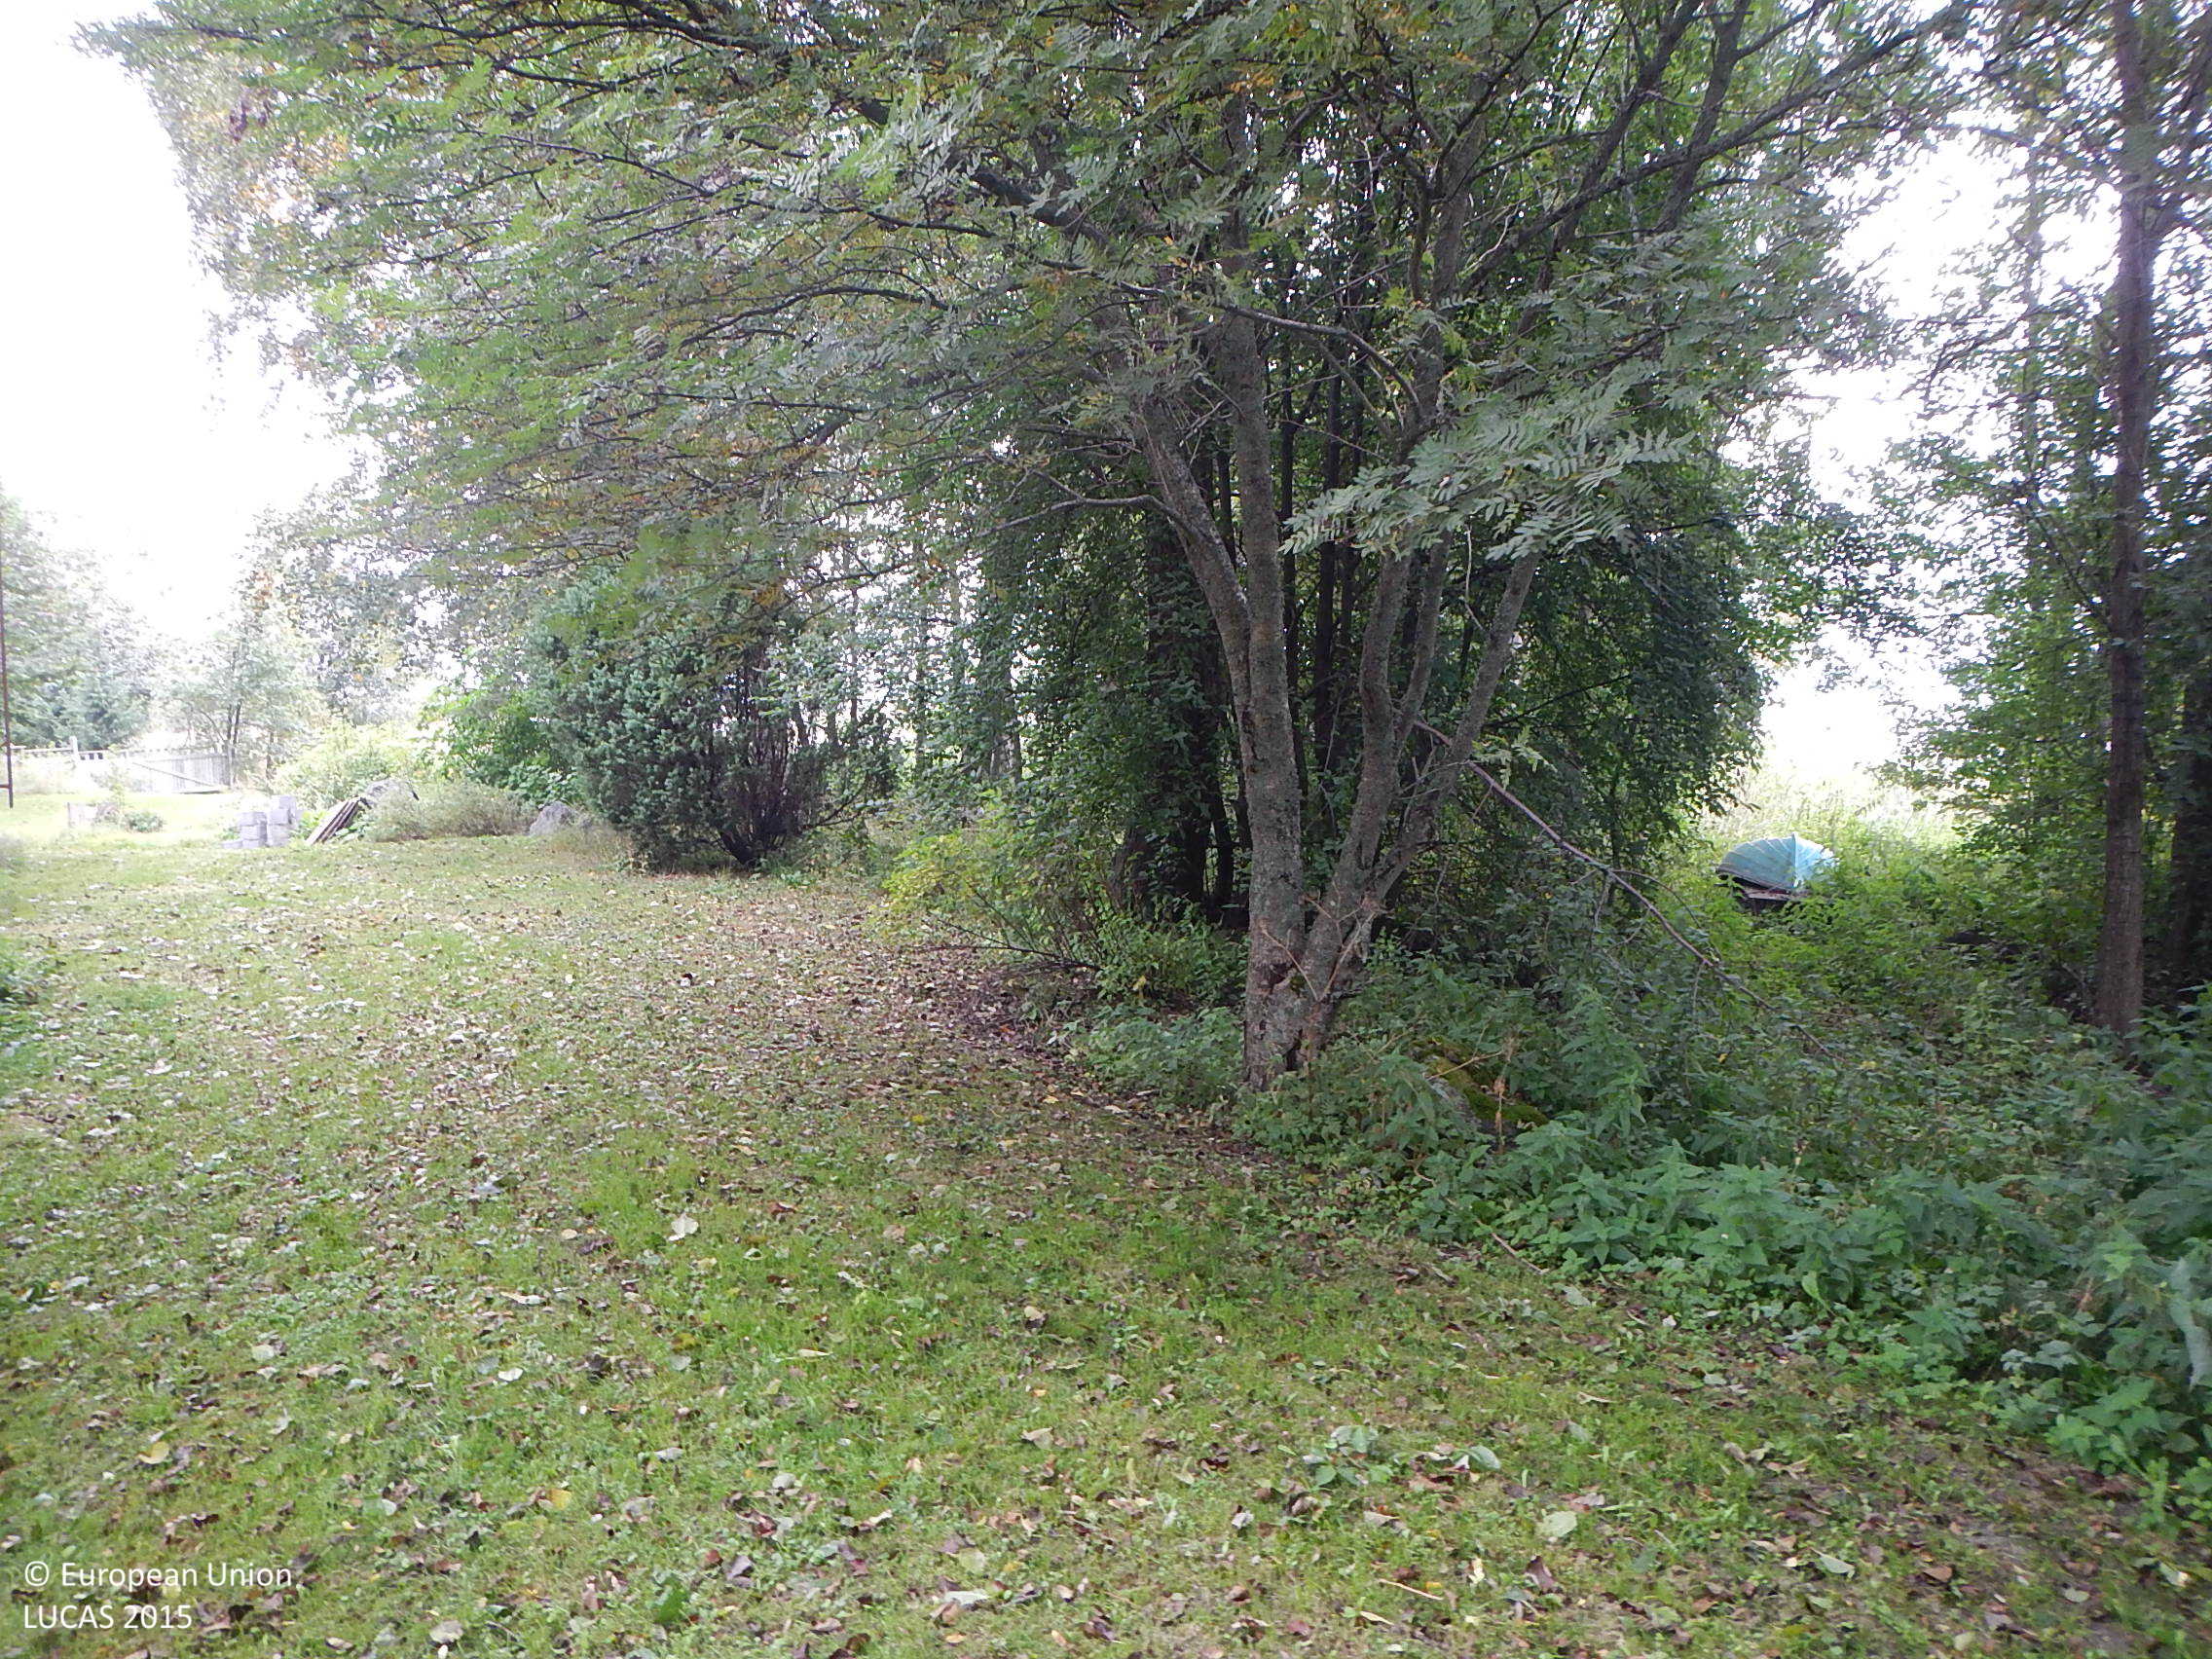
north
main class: Woodland
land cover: Broadleaved woodland
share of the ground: > 75 %
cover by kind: broadleaved forest trees 90 %, herbaceous plants 10 %
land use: Residential
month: September
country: FI
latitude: 61.6407
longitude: 21.5048
